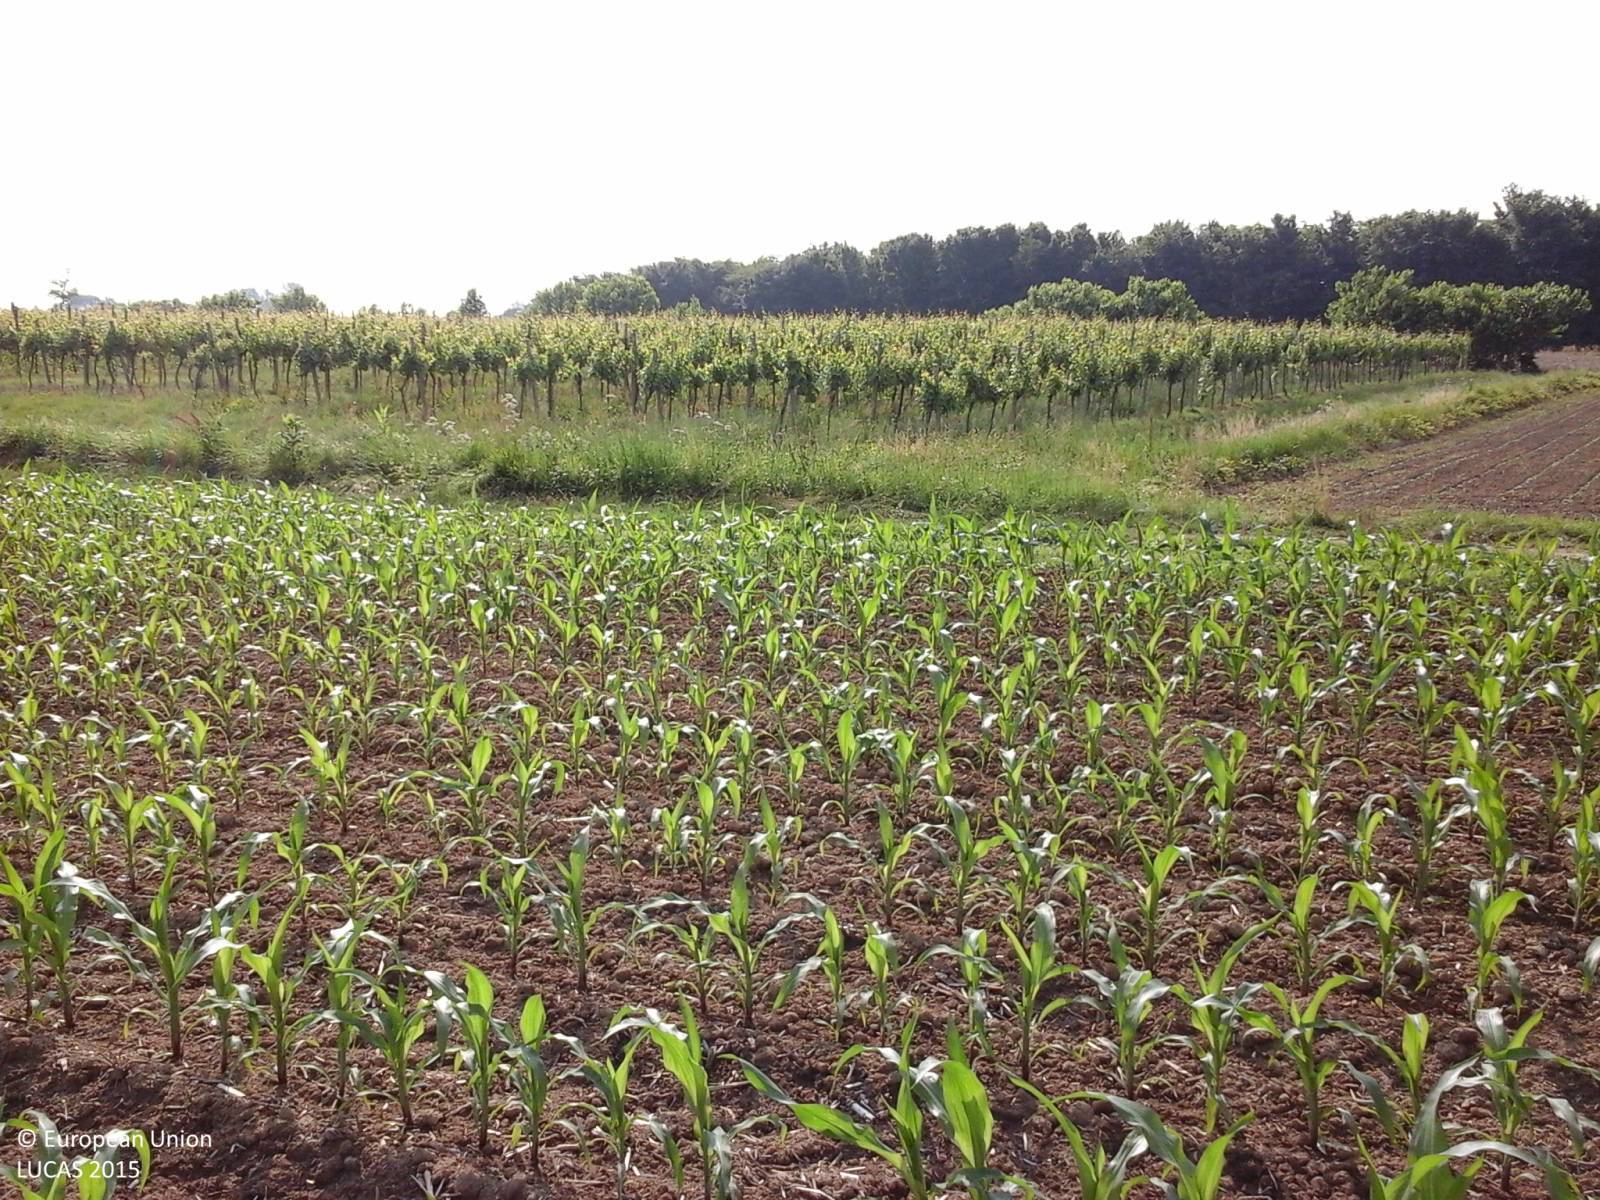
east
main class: Cropland
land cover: Maize
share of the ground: 10 - 25 %
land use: Agriculture (excluding fallow land and kitchen gardens)
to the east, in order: Maize; Tracks; Grass margins; Ditches and canals; Grass margins; Vineyards; Tracks; Vineyards; Tracks; Vineyards; Barley; Ditches and canals; Abandoned hedges; Soya; Tracks; Ditches and canals; Soya
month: May
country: IT
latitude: 45.8338
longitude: 13.2274
